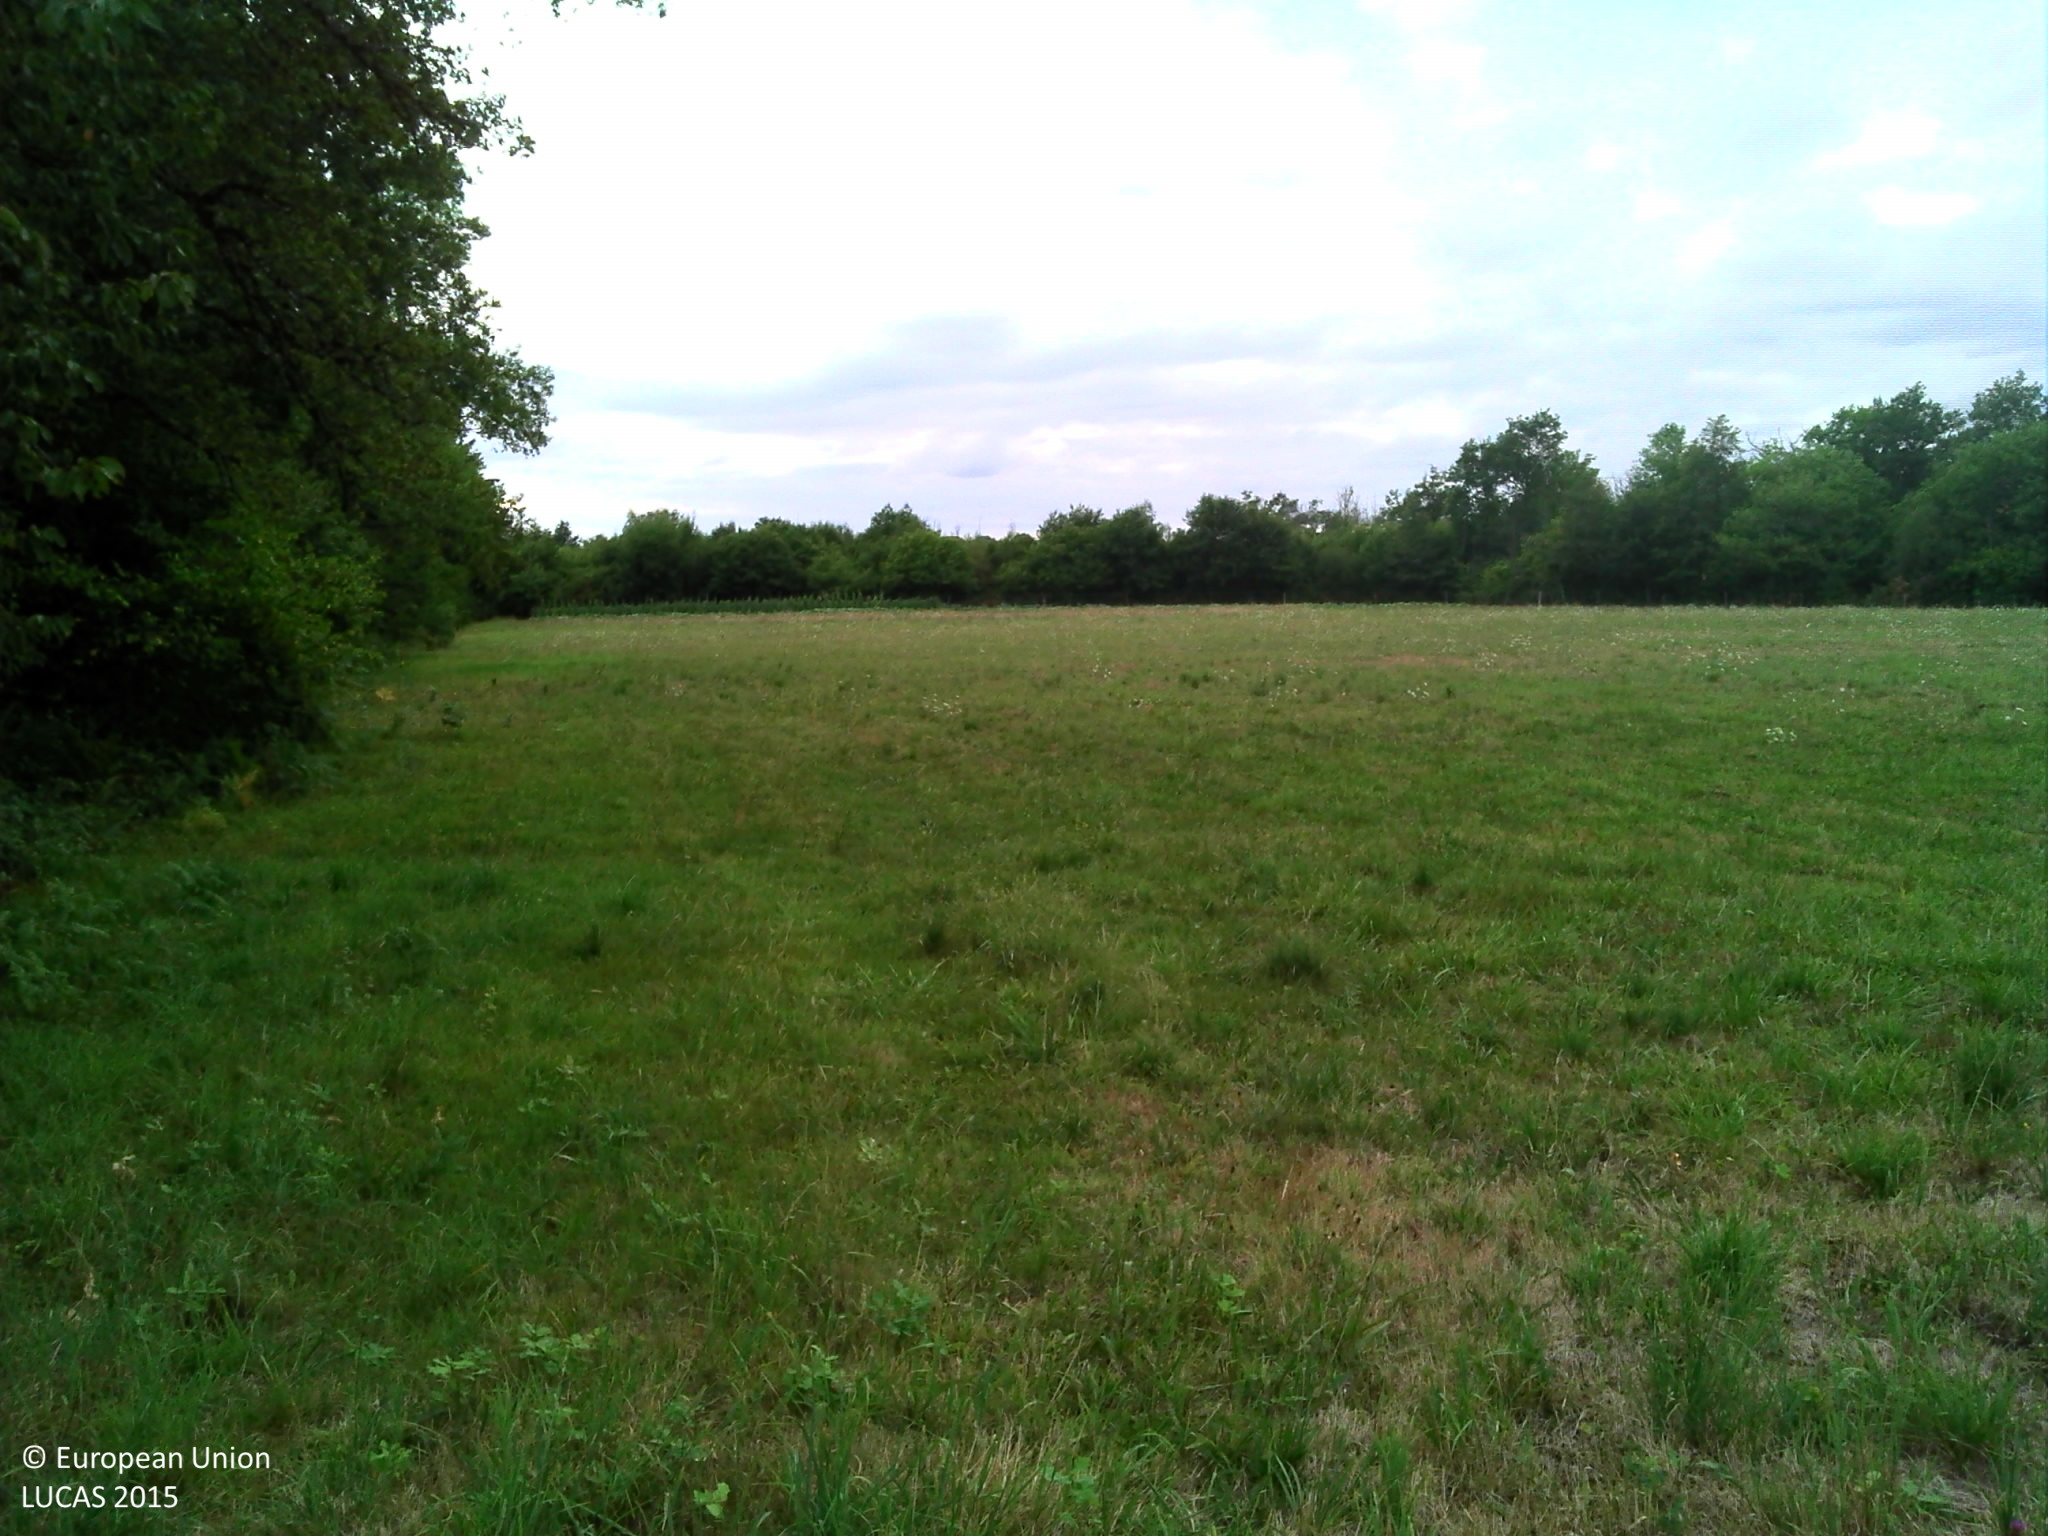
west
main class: Grassland
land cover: Grassland without tree/shrub cover
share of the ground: > 75 %
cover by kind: herbaceous plants 100 %
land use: Agriculture (excluding fallow land and kitchen gardens)
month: August
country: FR
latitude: 45.4545
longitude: 1.1042
